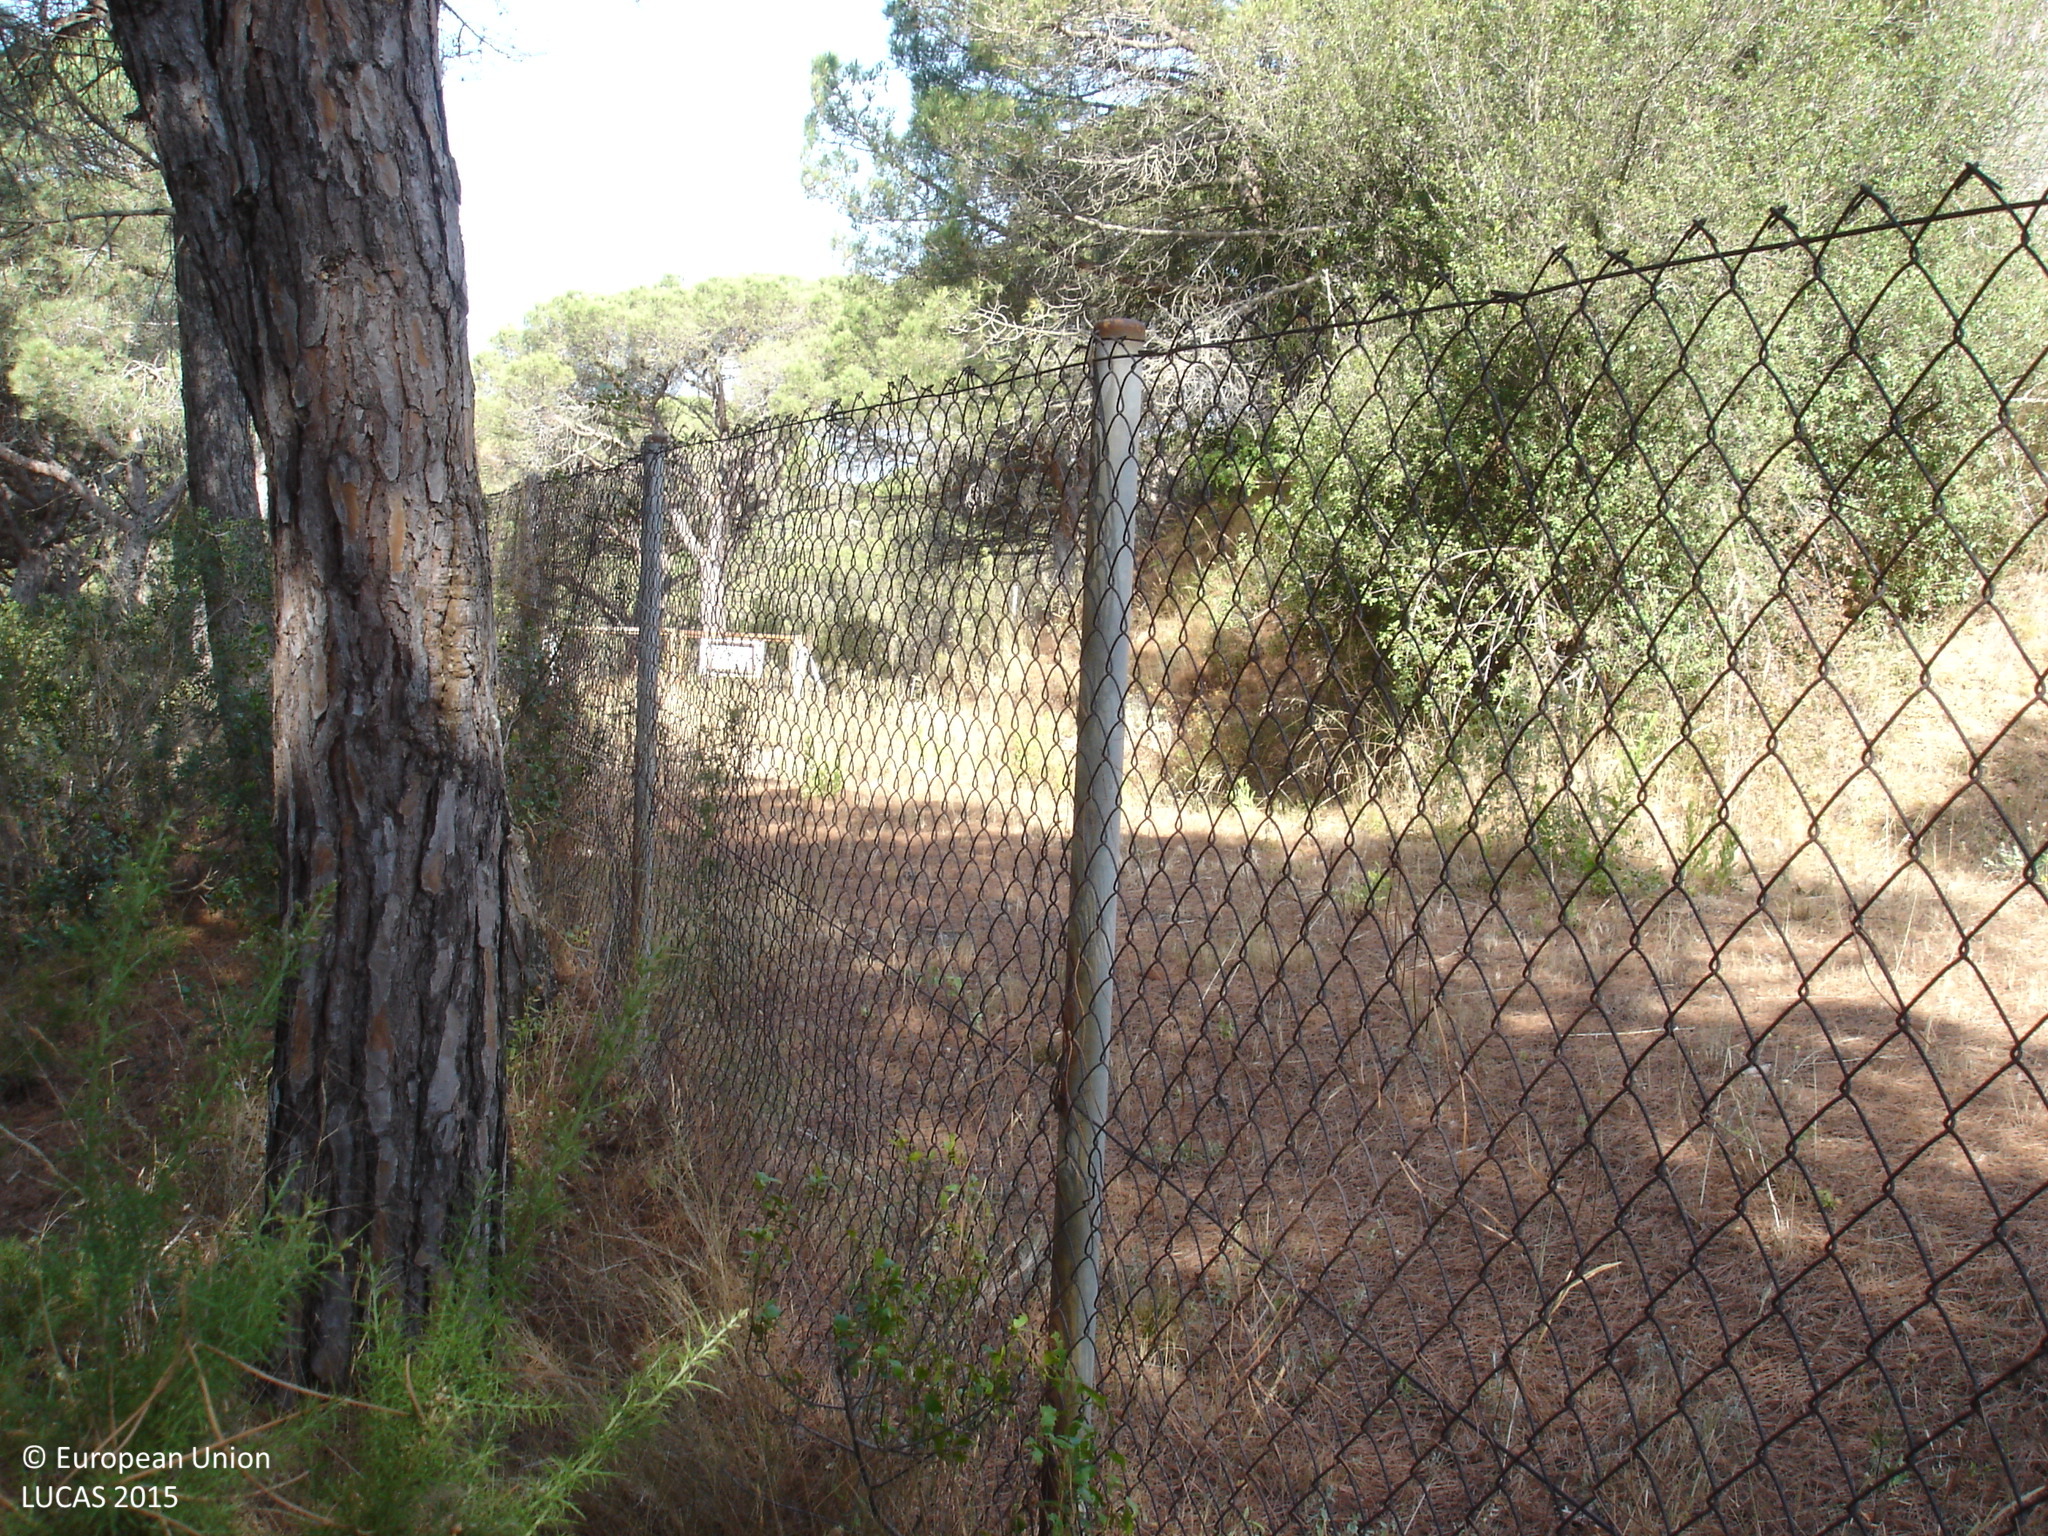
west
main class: Woodland
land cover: Pine dominated coniferous woodland
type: coniferous forest of the mediterranean region
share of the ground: 50 - 75 %
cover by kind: coniferous forest trees 70 %, herbaceous plants 25 %, broadleaved forest trees 5 %
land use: Forestry
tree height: > 5 m
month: July
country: ES
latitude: 41.7971
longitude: 3.0247
